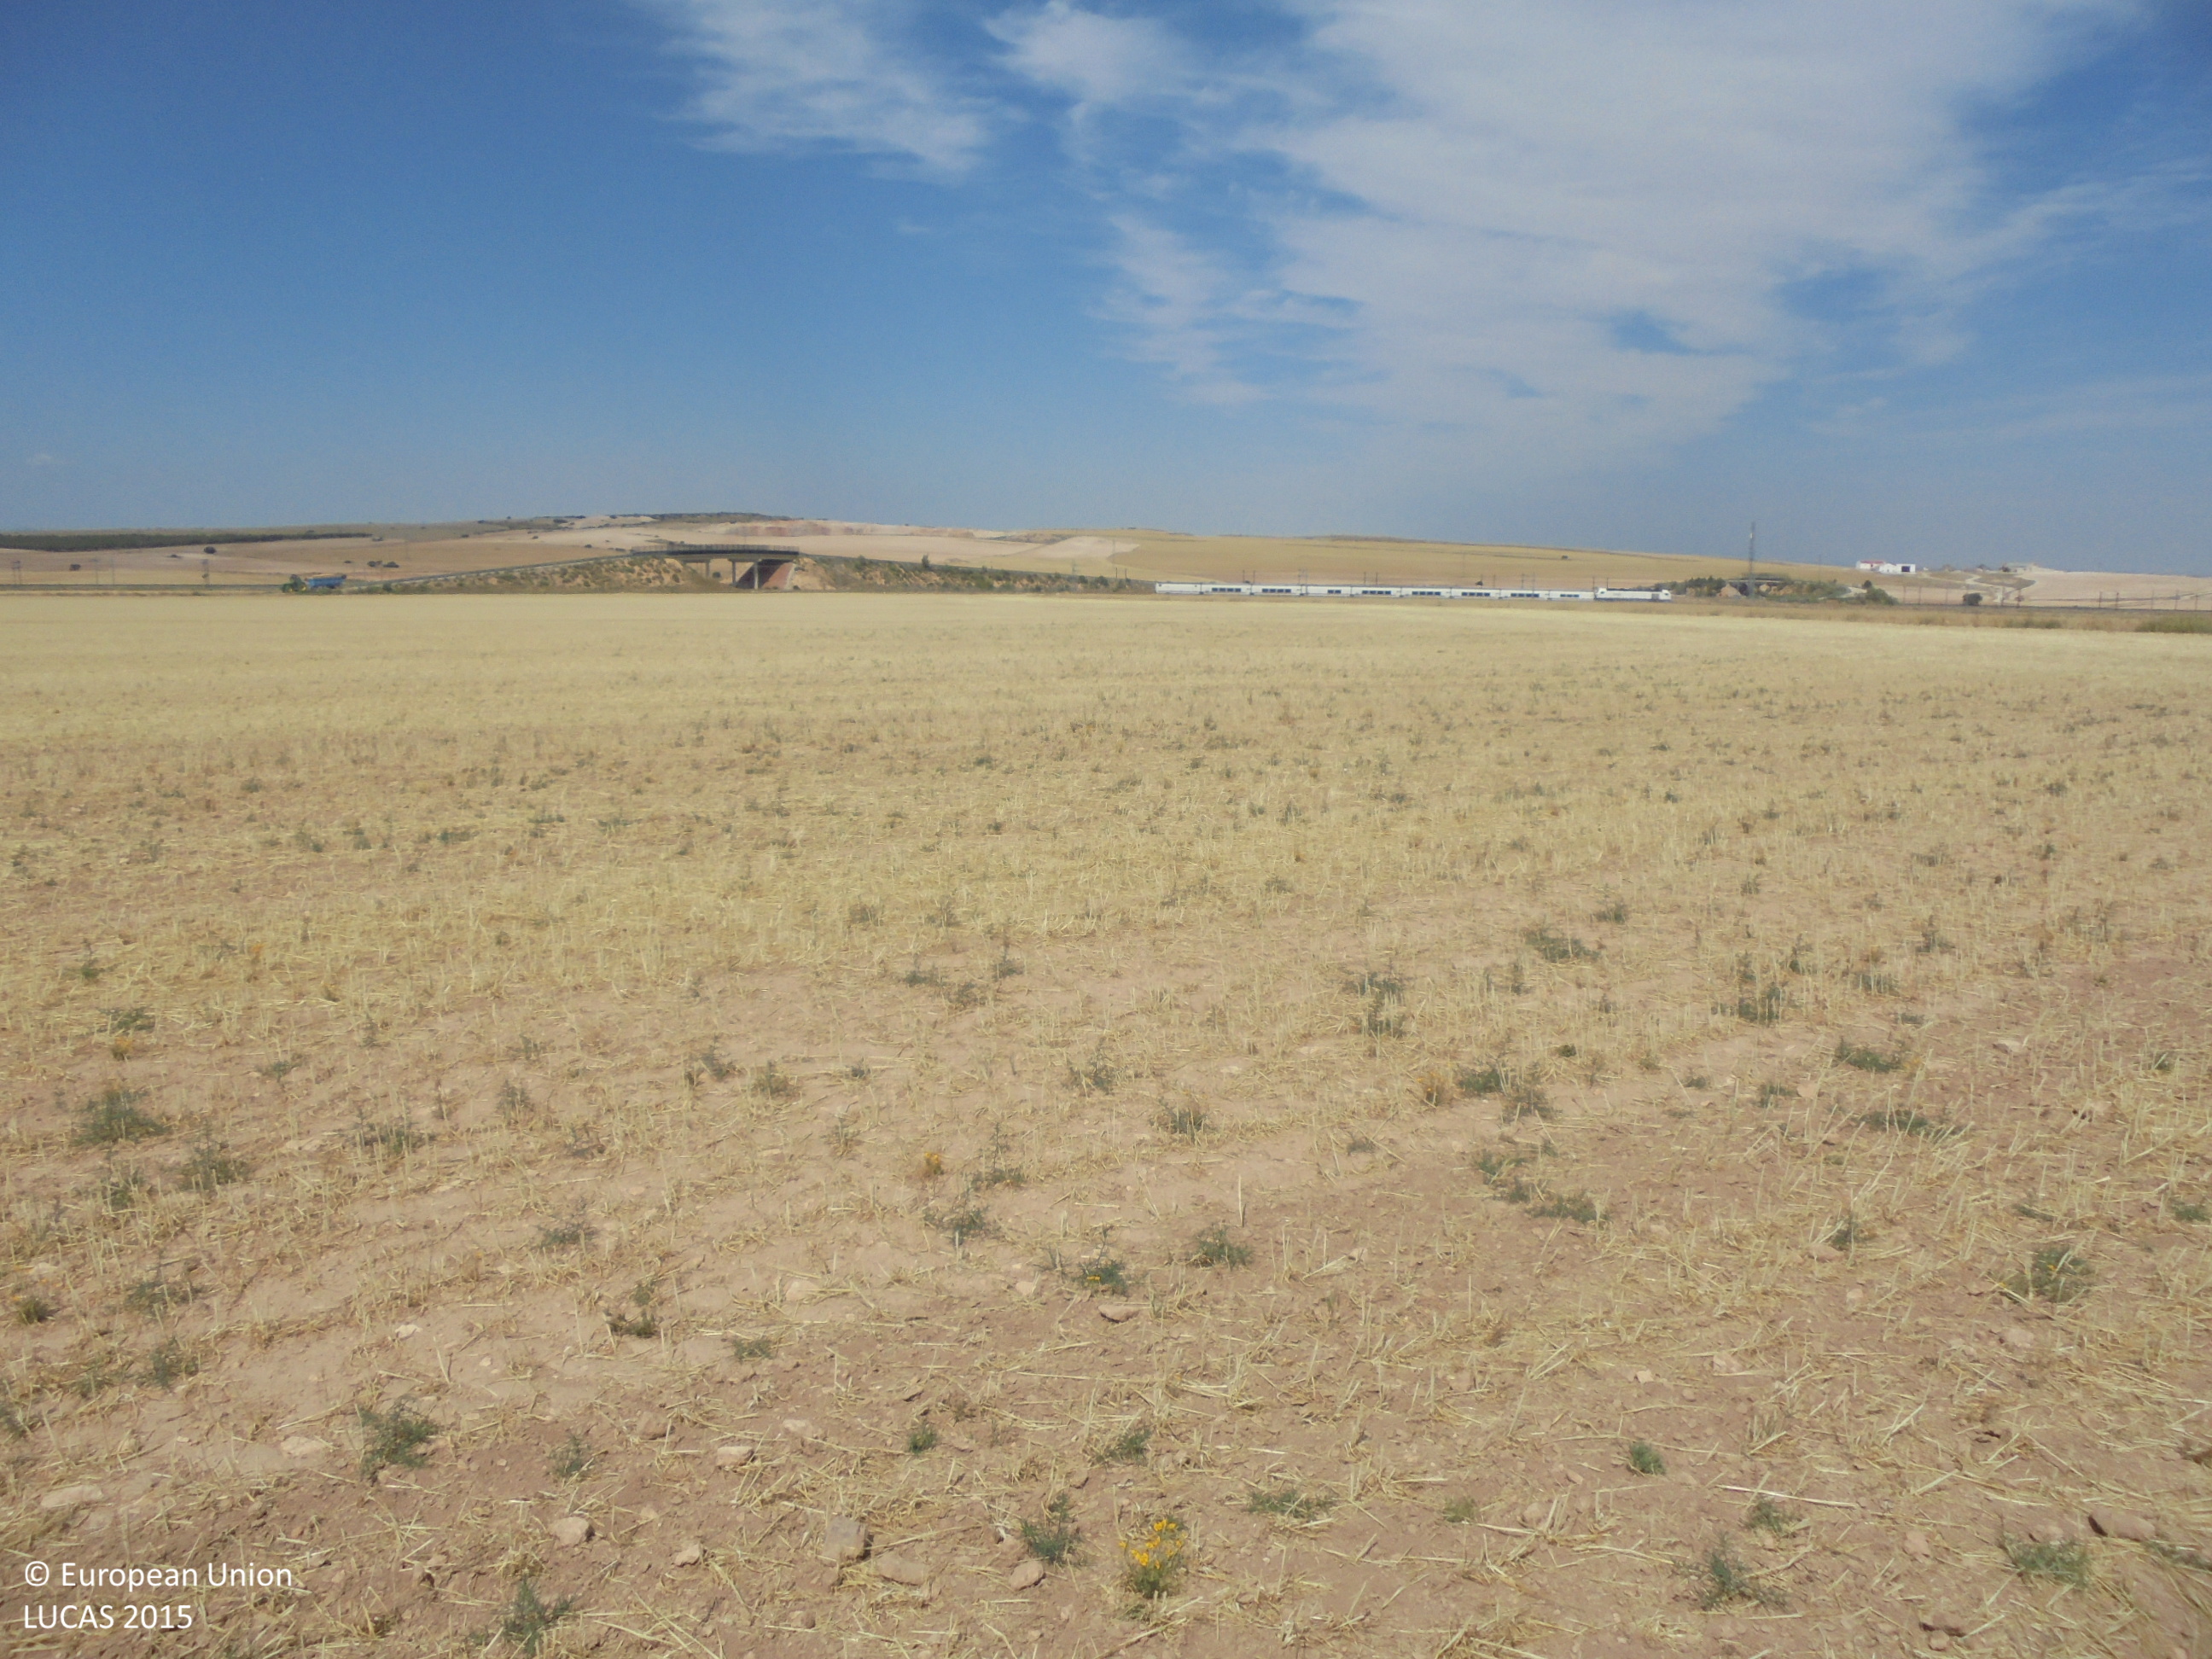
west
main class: Cropland
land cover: Barley
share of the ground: < 10 %
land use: Agriculture (excluding fallow land and kitchen gardens)
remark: Harvested field
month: June
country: ES
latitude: 38.9189
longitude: -1.7514
